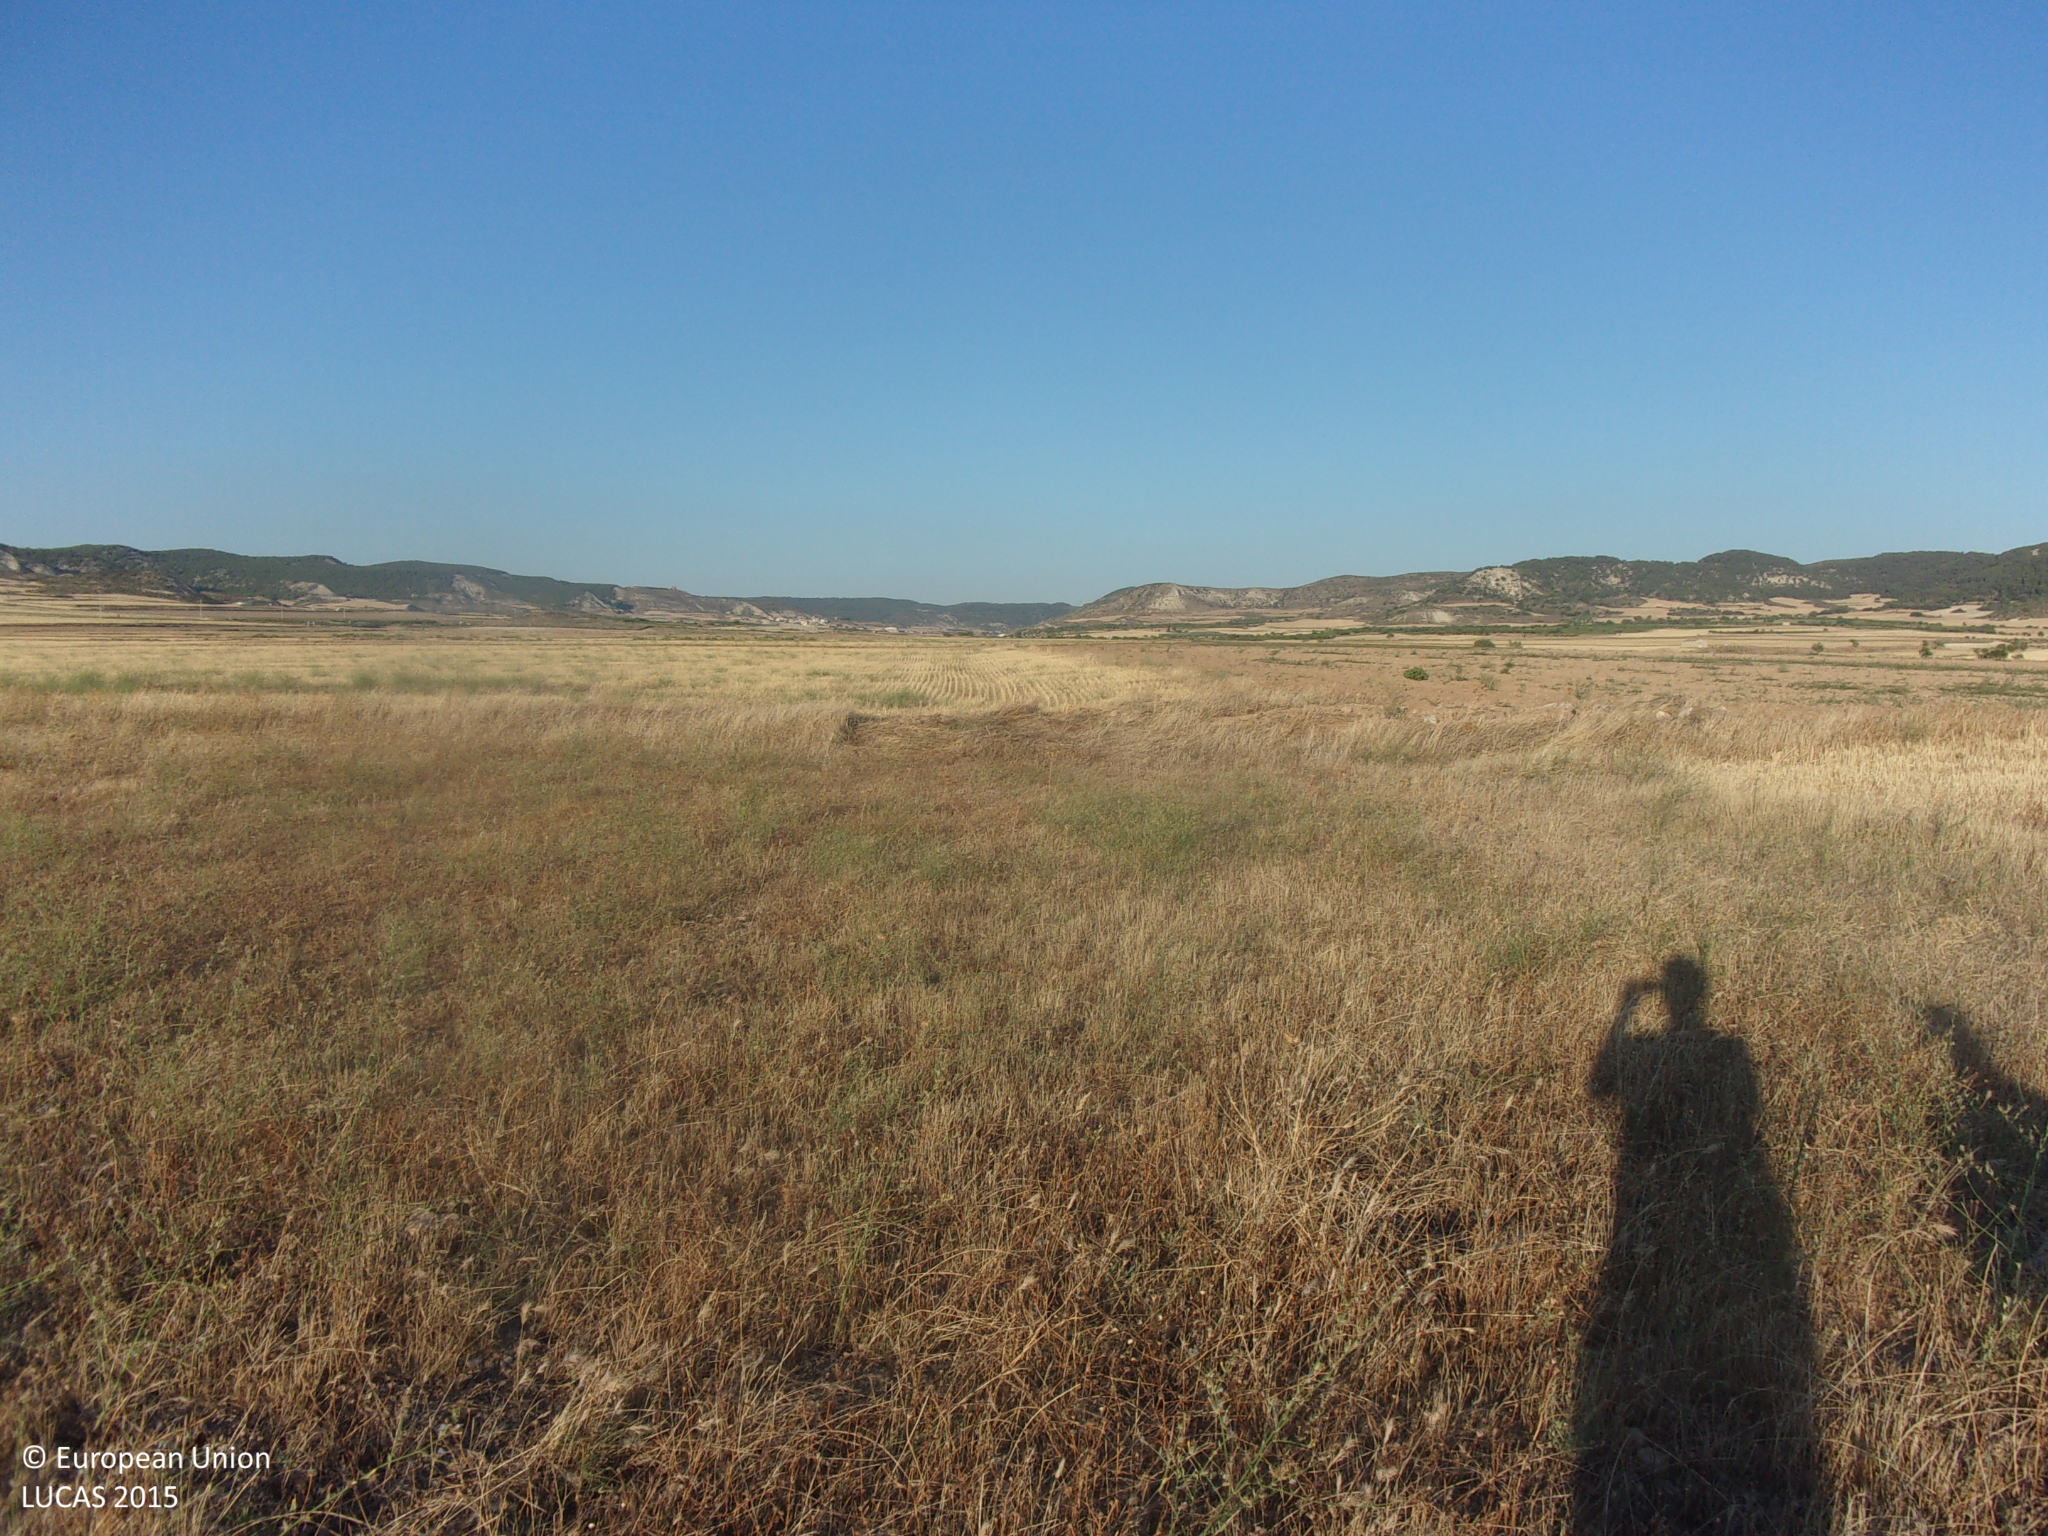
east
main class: Grassland
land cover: Spontaneously vegetated surfaces
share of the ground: > 75 %
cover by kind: herbaceous plants 100 %
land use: Fallow land
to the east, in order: Spontaneously vegetated surfaces; Grass margins; Durum wheat; Grass margins; Other bare soil
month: July
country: ES
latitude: 41.9753
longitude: -1.0442
